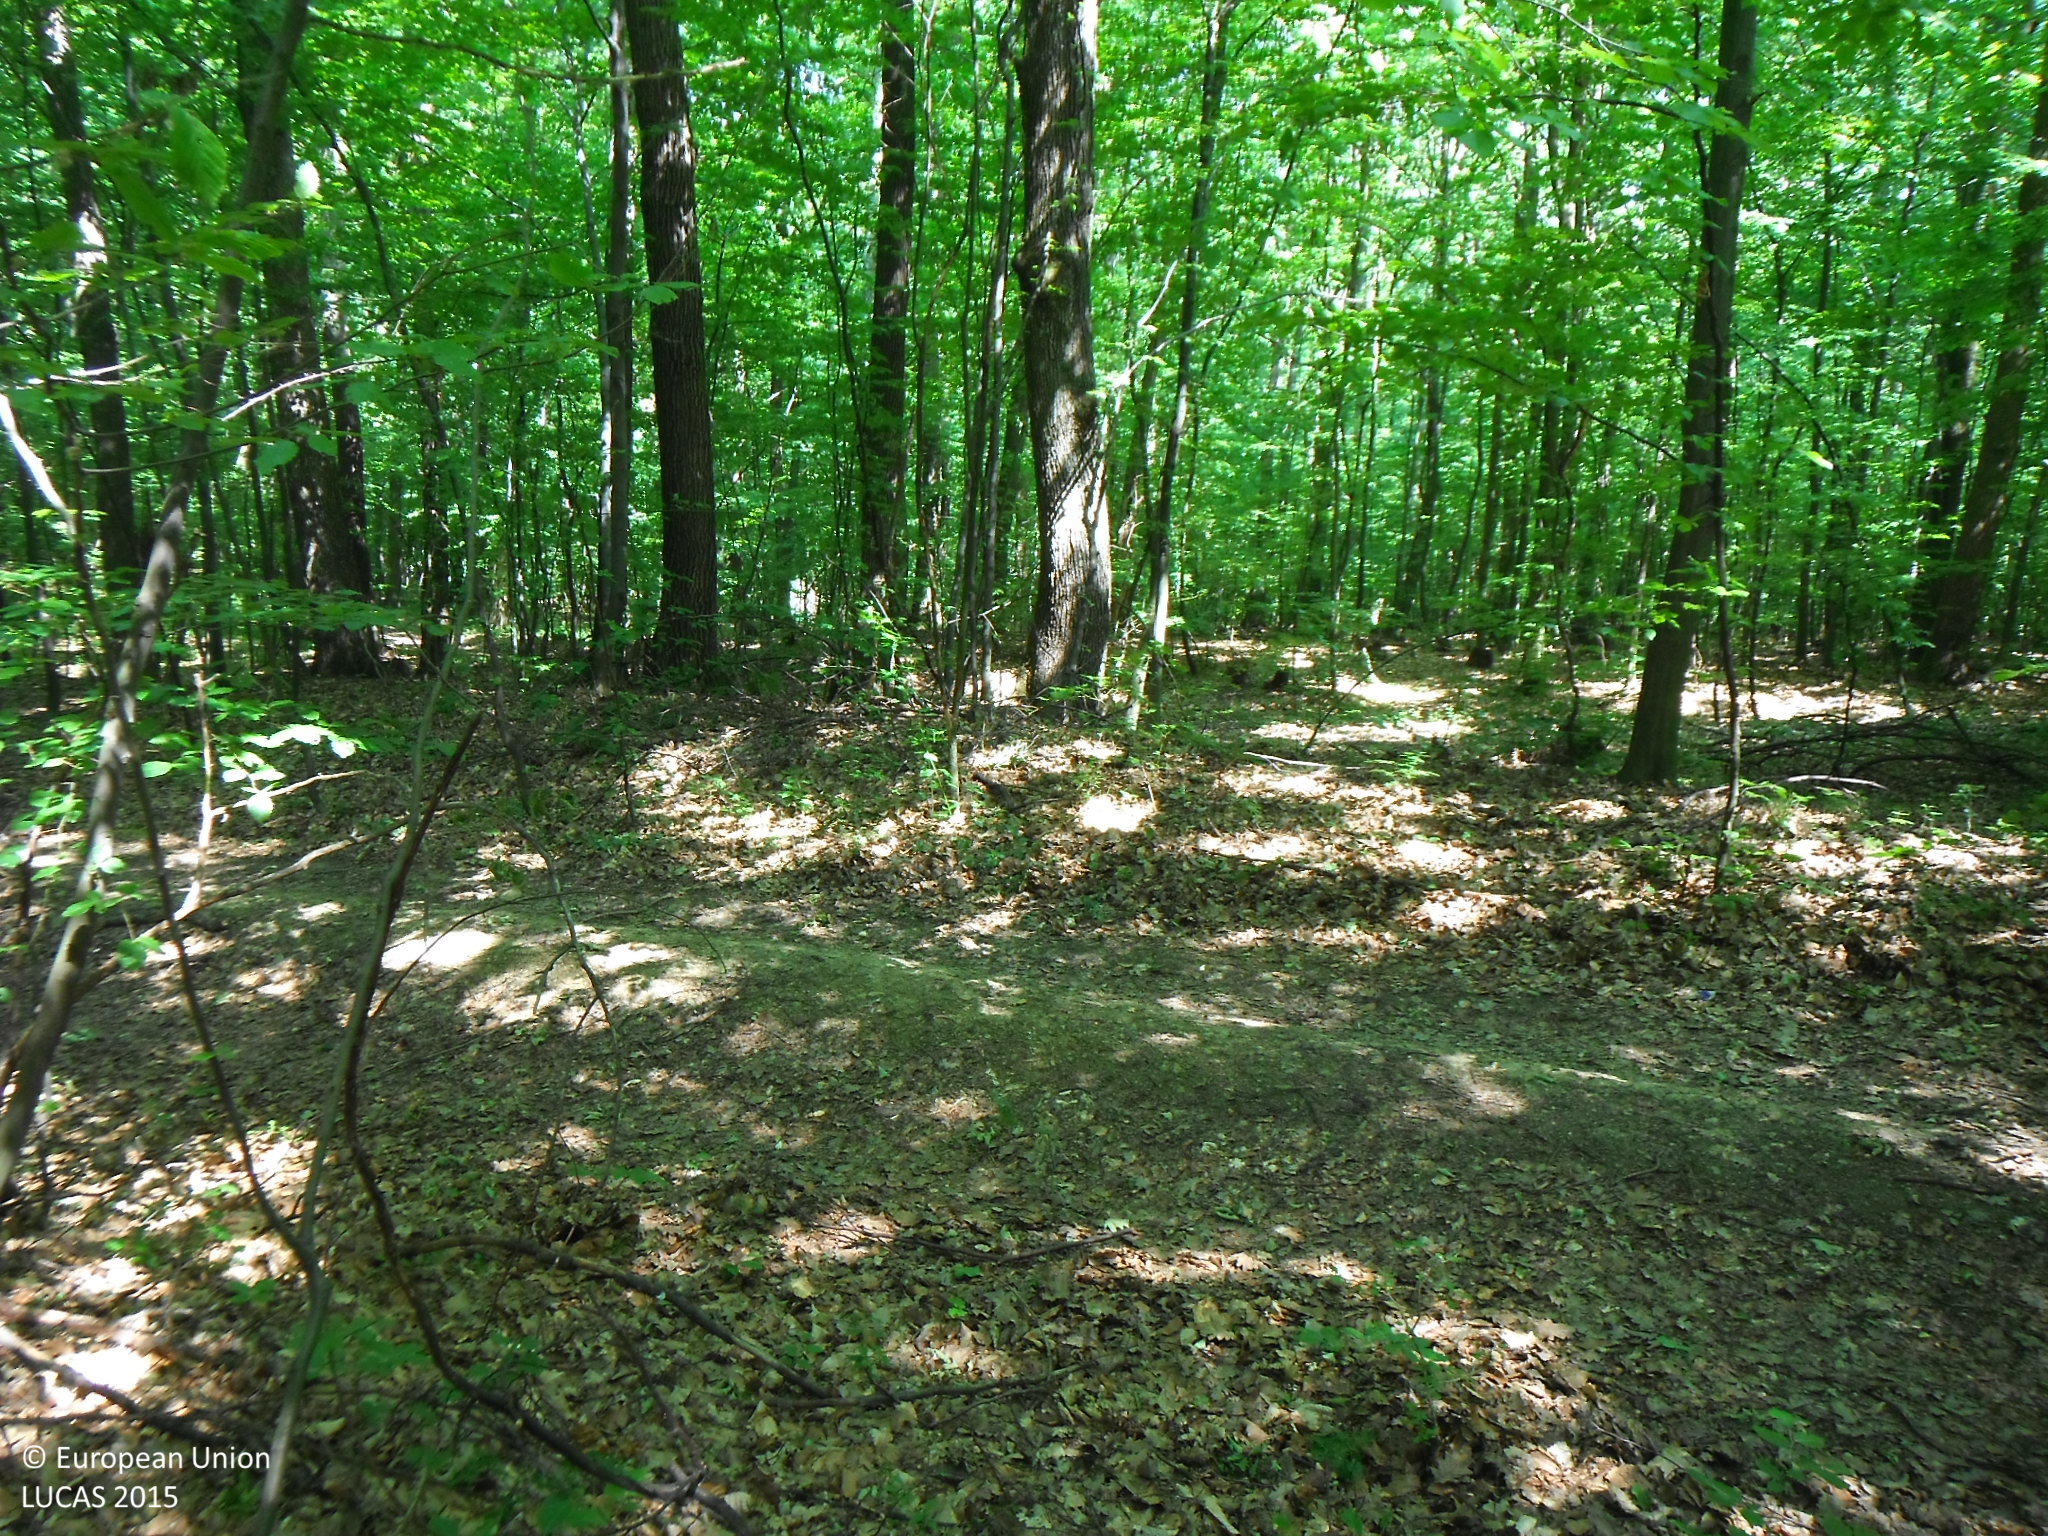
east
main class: Woodland
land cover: Broadleaved woodland
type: beech forest
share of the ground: > 75 %
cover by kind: broadleaved forest trees 95 %, shrubs 5 %
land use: Forestry
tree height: > 5 m
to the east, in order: Broadleaved woodland; Tracks; Broadleaved woodland; Grassland without tree/shrub cover; Tracks; Spontaneously vegetated surfaces; Broadleaved woodland; Ditches and canals; Broadleaved woodland; Other bare soil; Shrubland with sparse tree cover
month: June
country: SK
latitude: 48.8674
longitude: 21.9005
